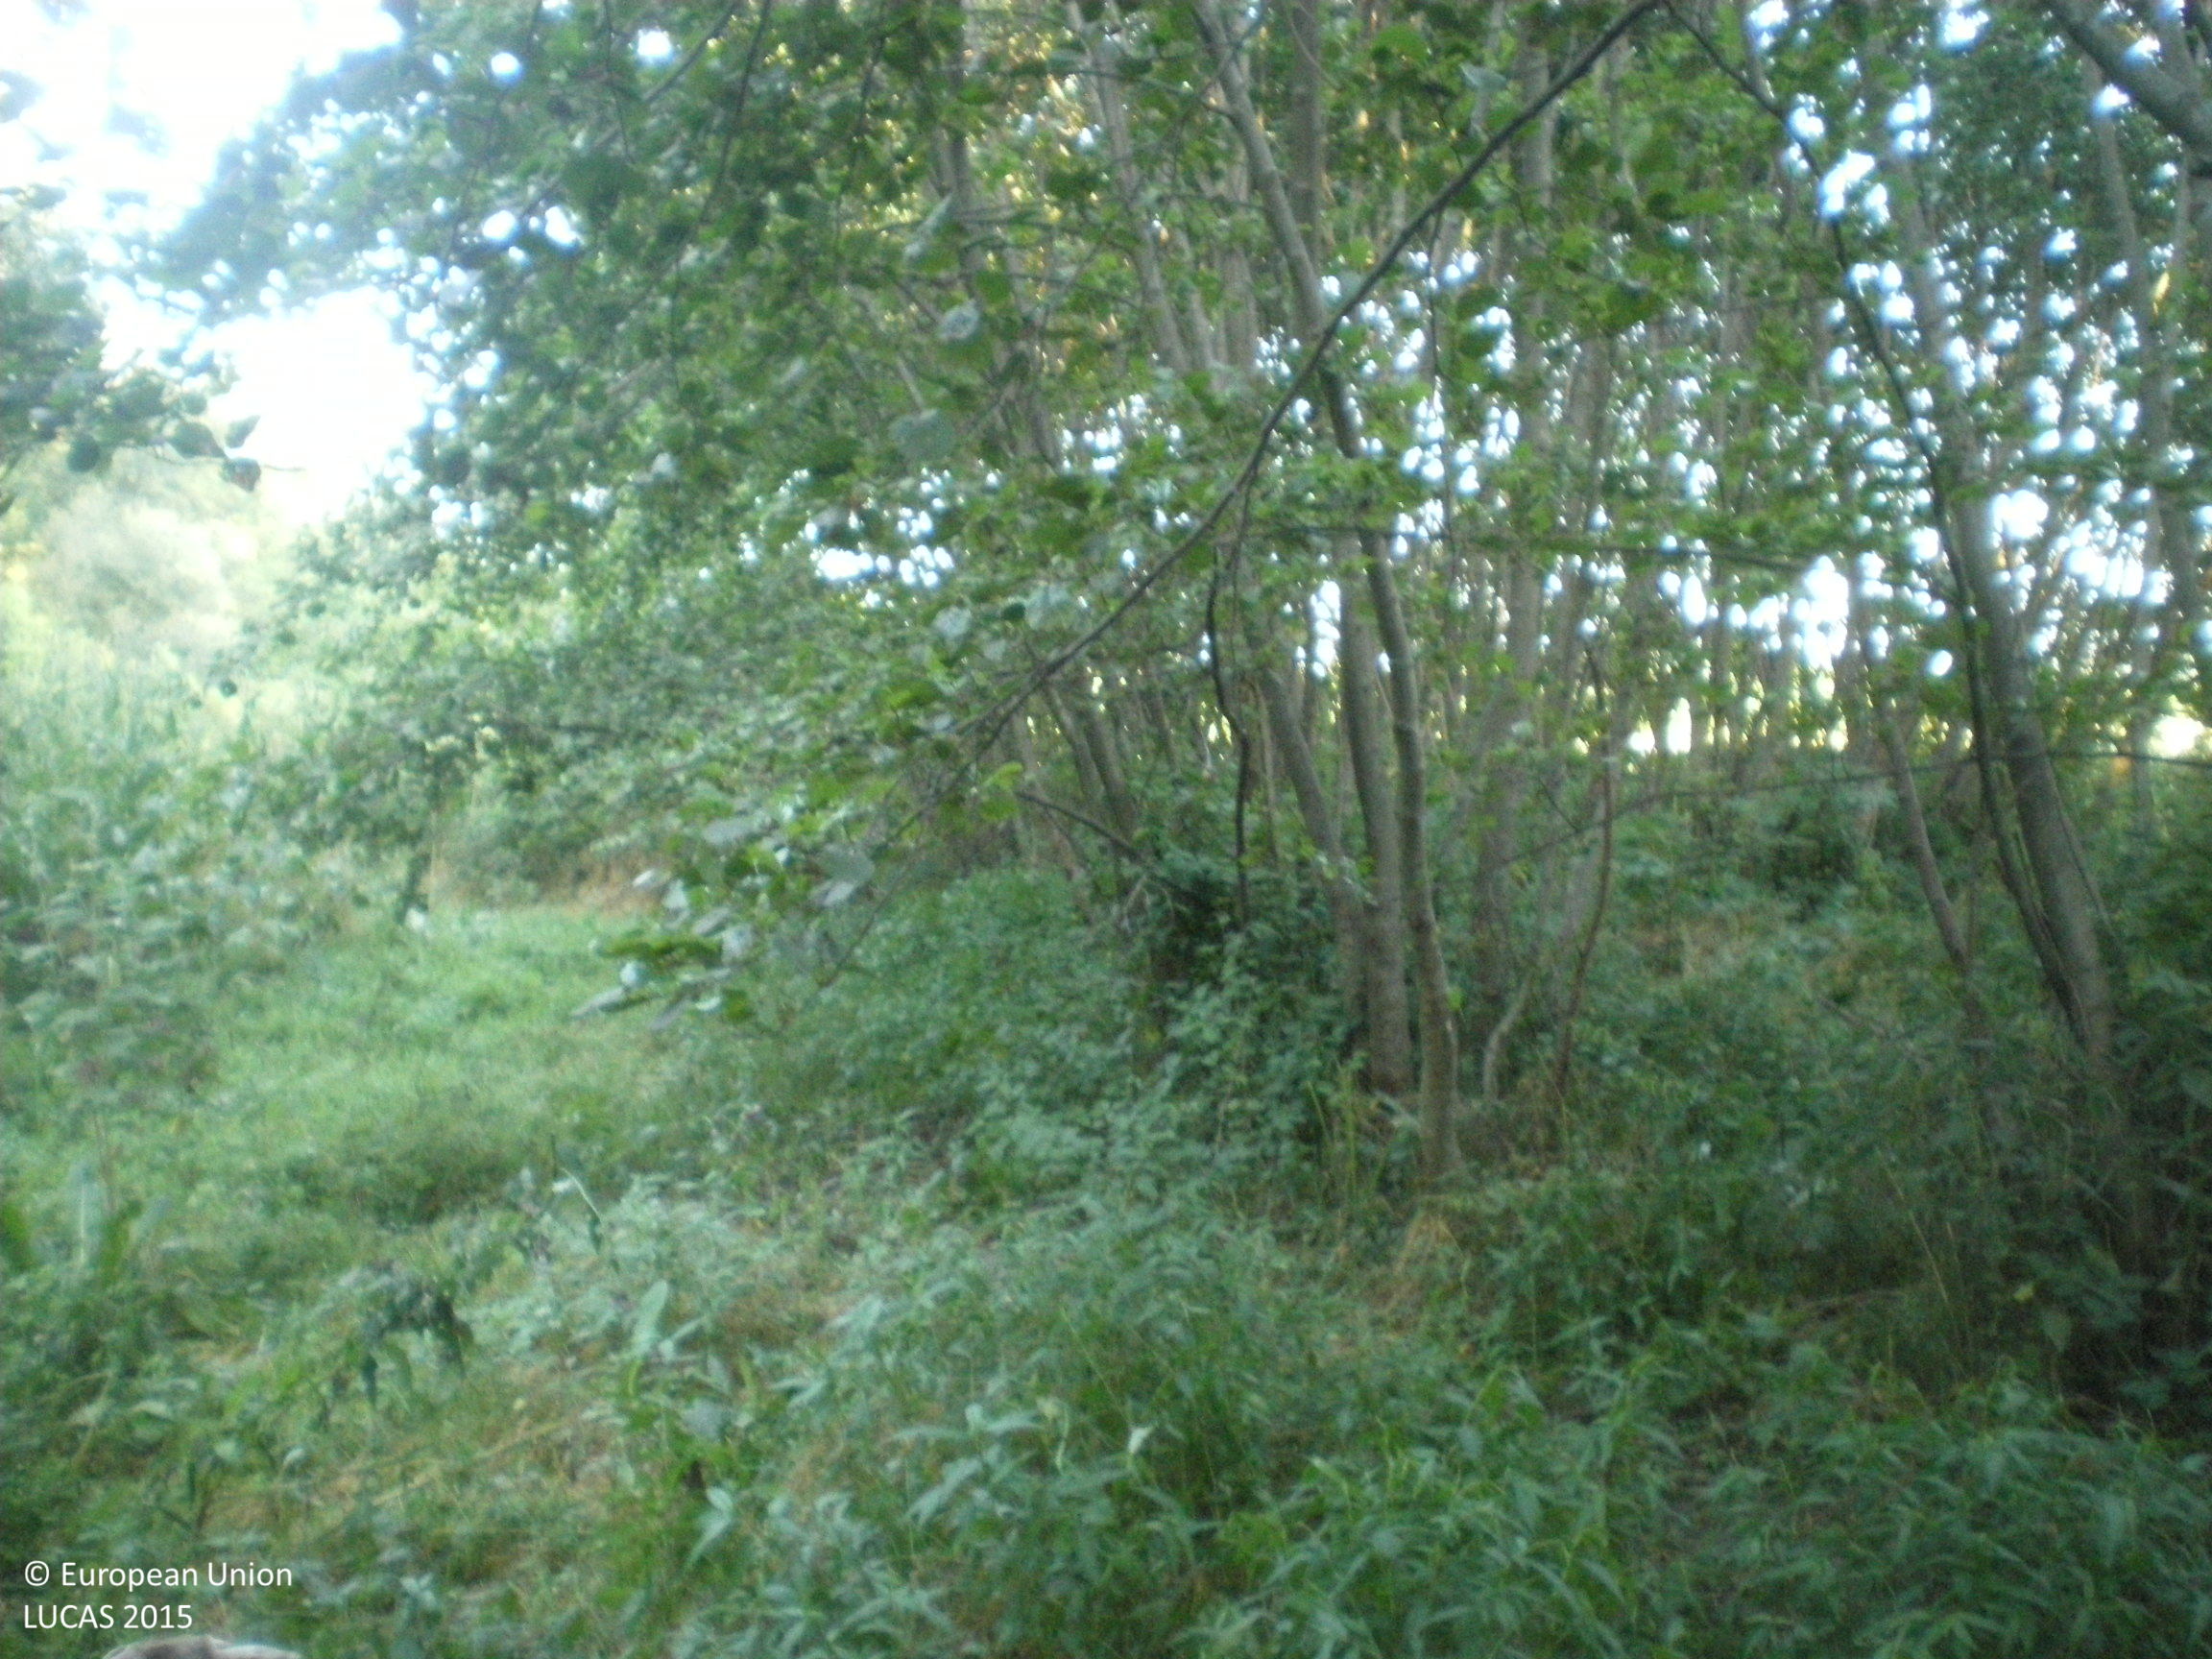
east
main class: Woodland
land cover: Broadleaved woodland
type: mesophytic deciduous forest
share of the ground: > 75 %
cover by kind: broadleaved forest trees 85 %, herbaceous plants 15 %
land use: Forestry
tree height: > 5 m
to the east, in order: Broadleaved woodland; Grassland without tree/shrub cover; Grassland with sparse tree/shrub cover; Grassland without tree/shrub cover; Grassland with sparse tree/shrub cover
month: July
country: BG
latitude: 42.6151
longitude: 25.2191
